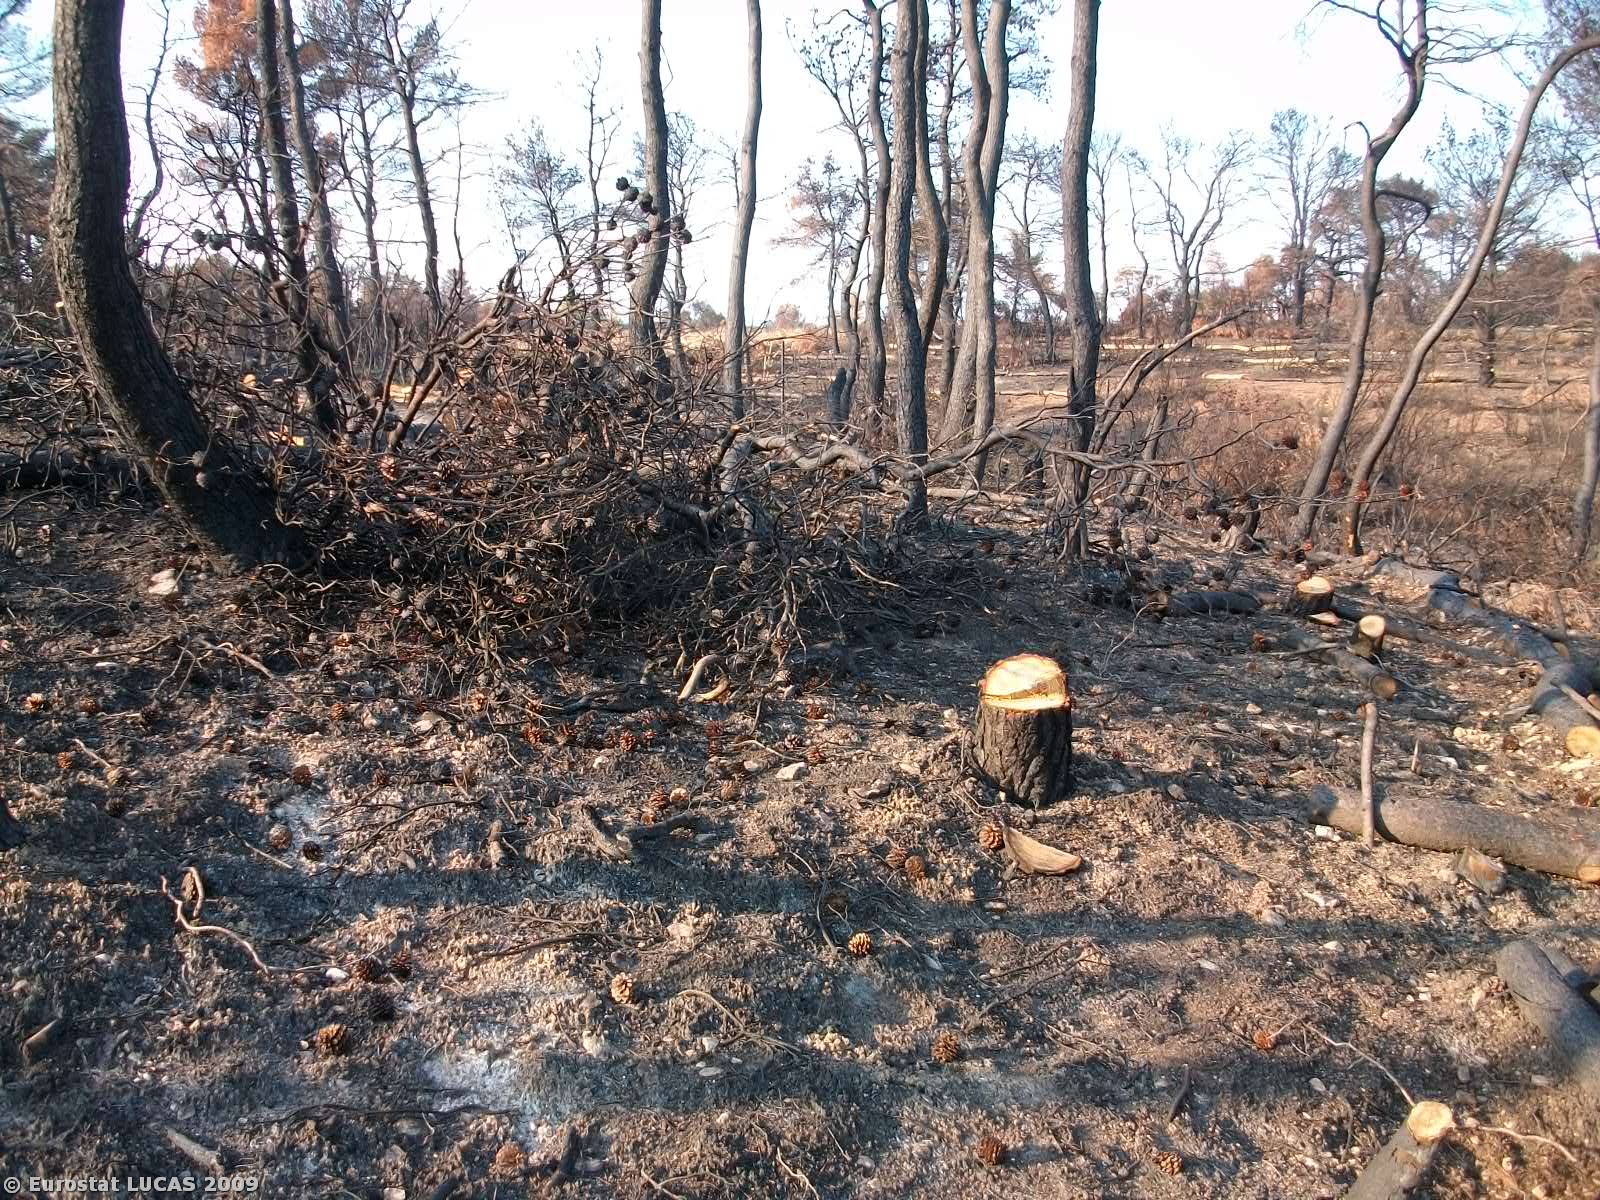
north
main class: Woodland
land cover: Coniferous woodland
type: coniferous forest of the mediterranean region
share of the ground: > 75 %
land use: Forestry
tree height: > 5 m
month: September
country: GR
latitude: 38.1720
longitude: 23.8998
